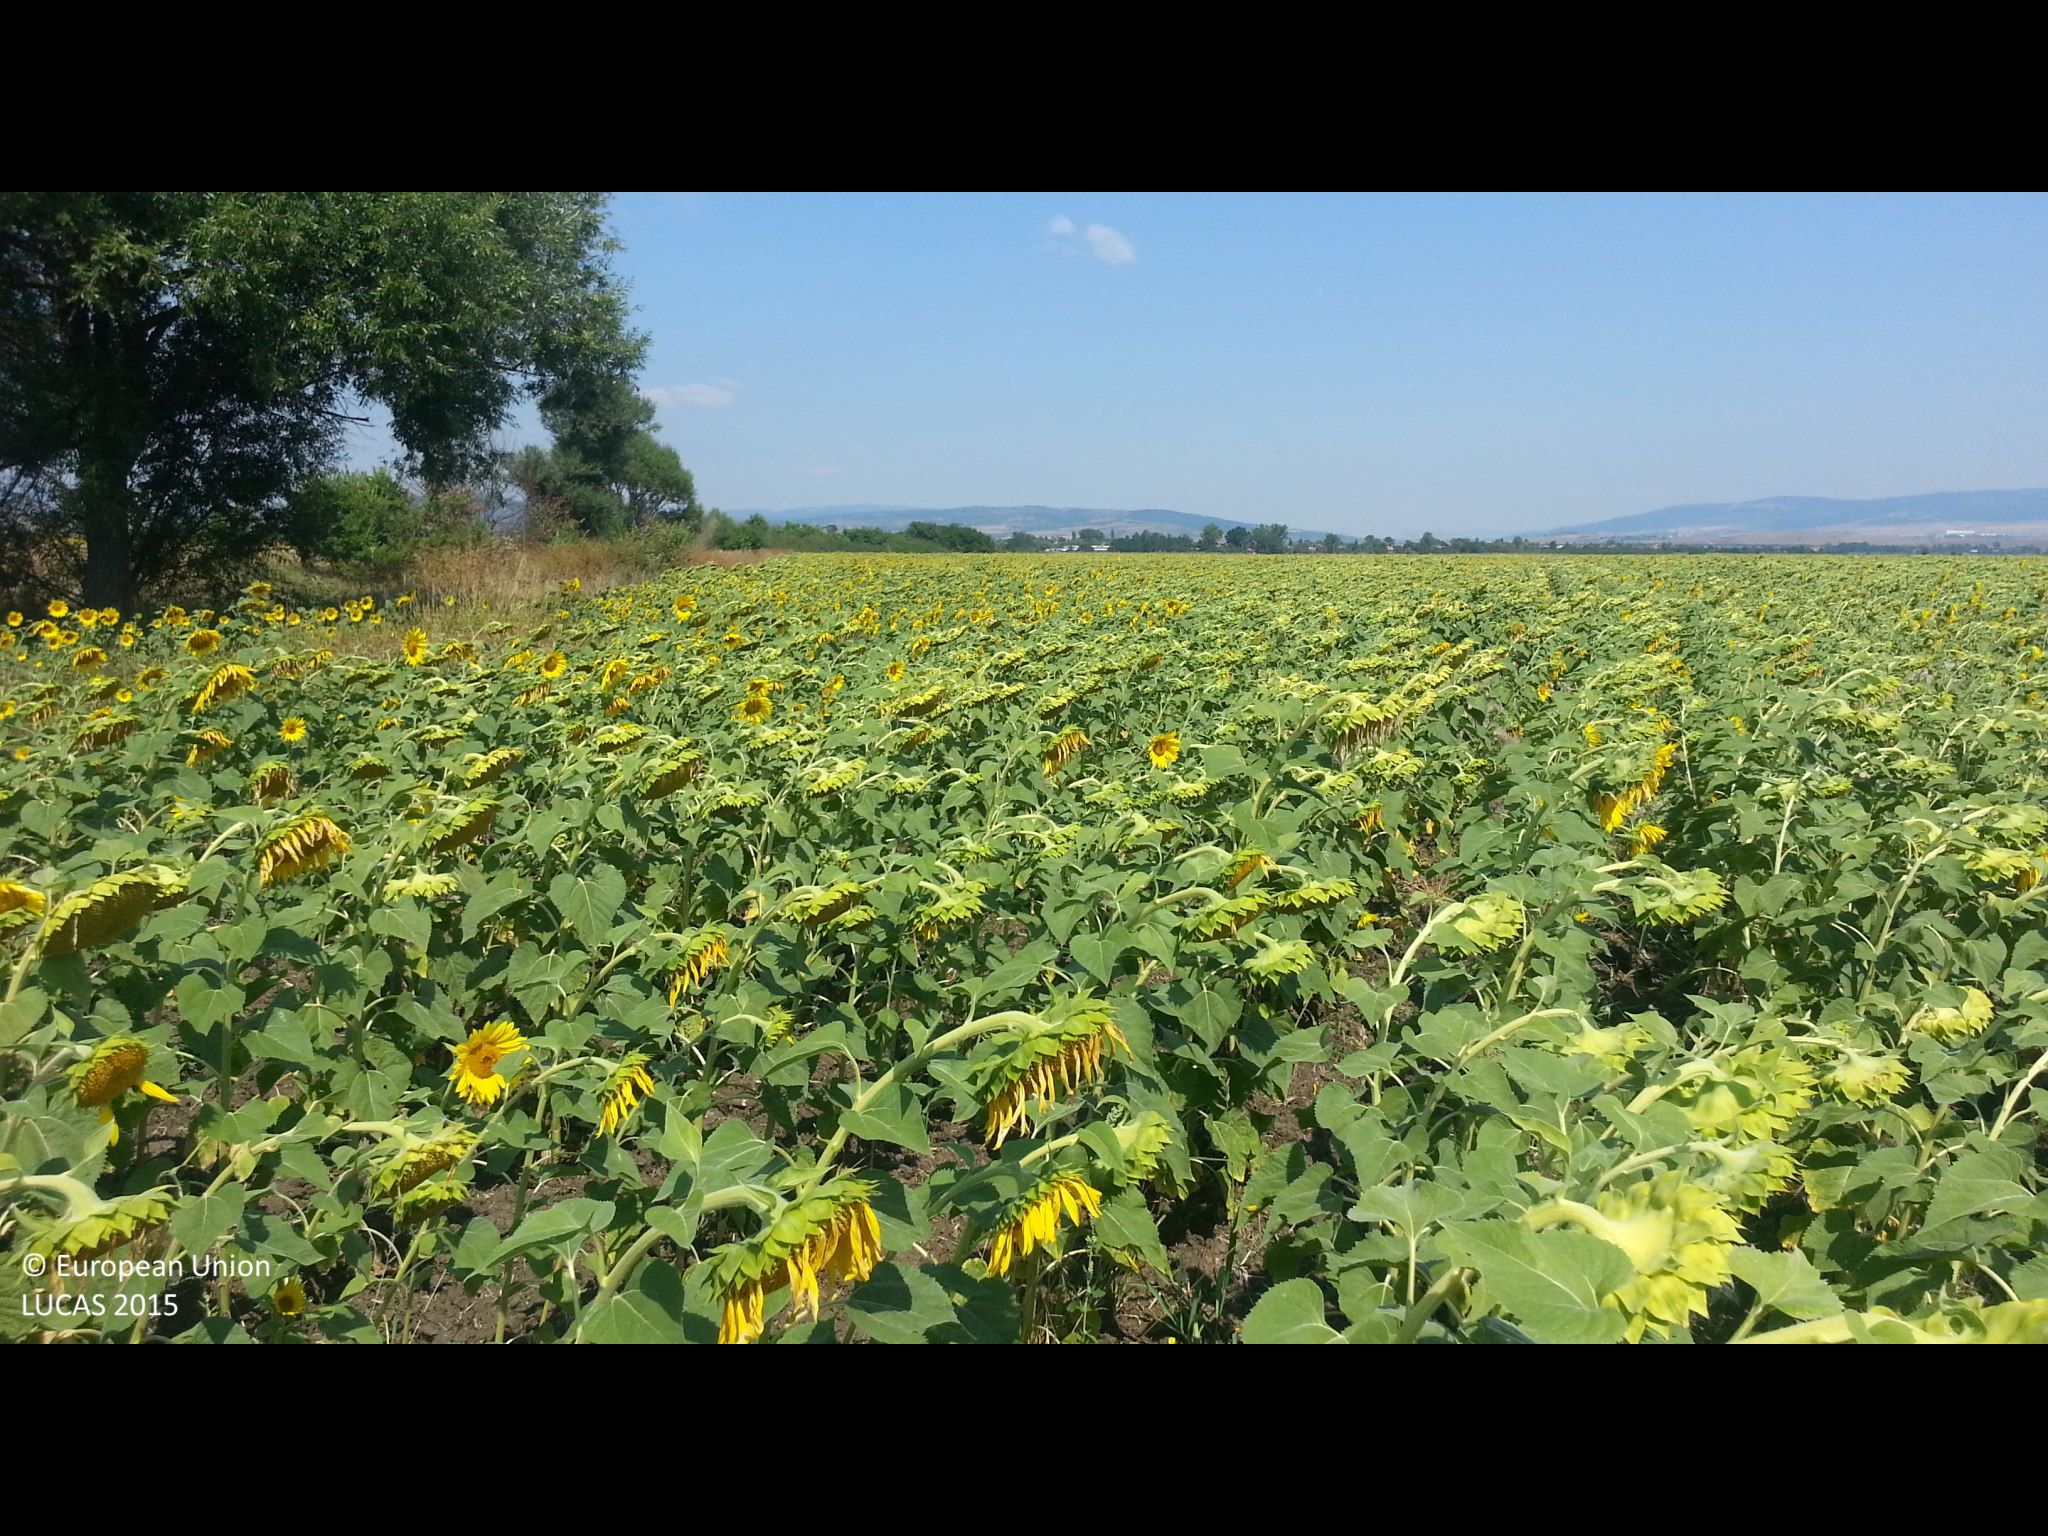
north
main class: Cropland
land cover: Sunflower
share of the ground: > 75 %
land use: Agriculture (excluding fallow land and kitchen gardens)
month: August
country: BG
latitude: 42.4399
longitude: 22.9494
